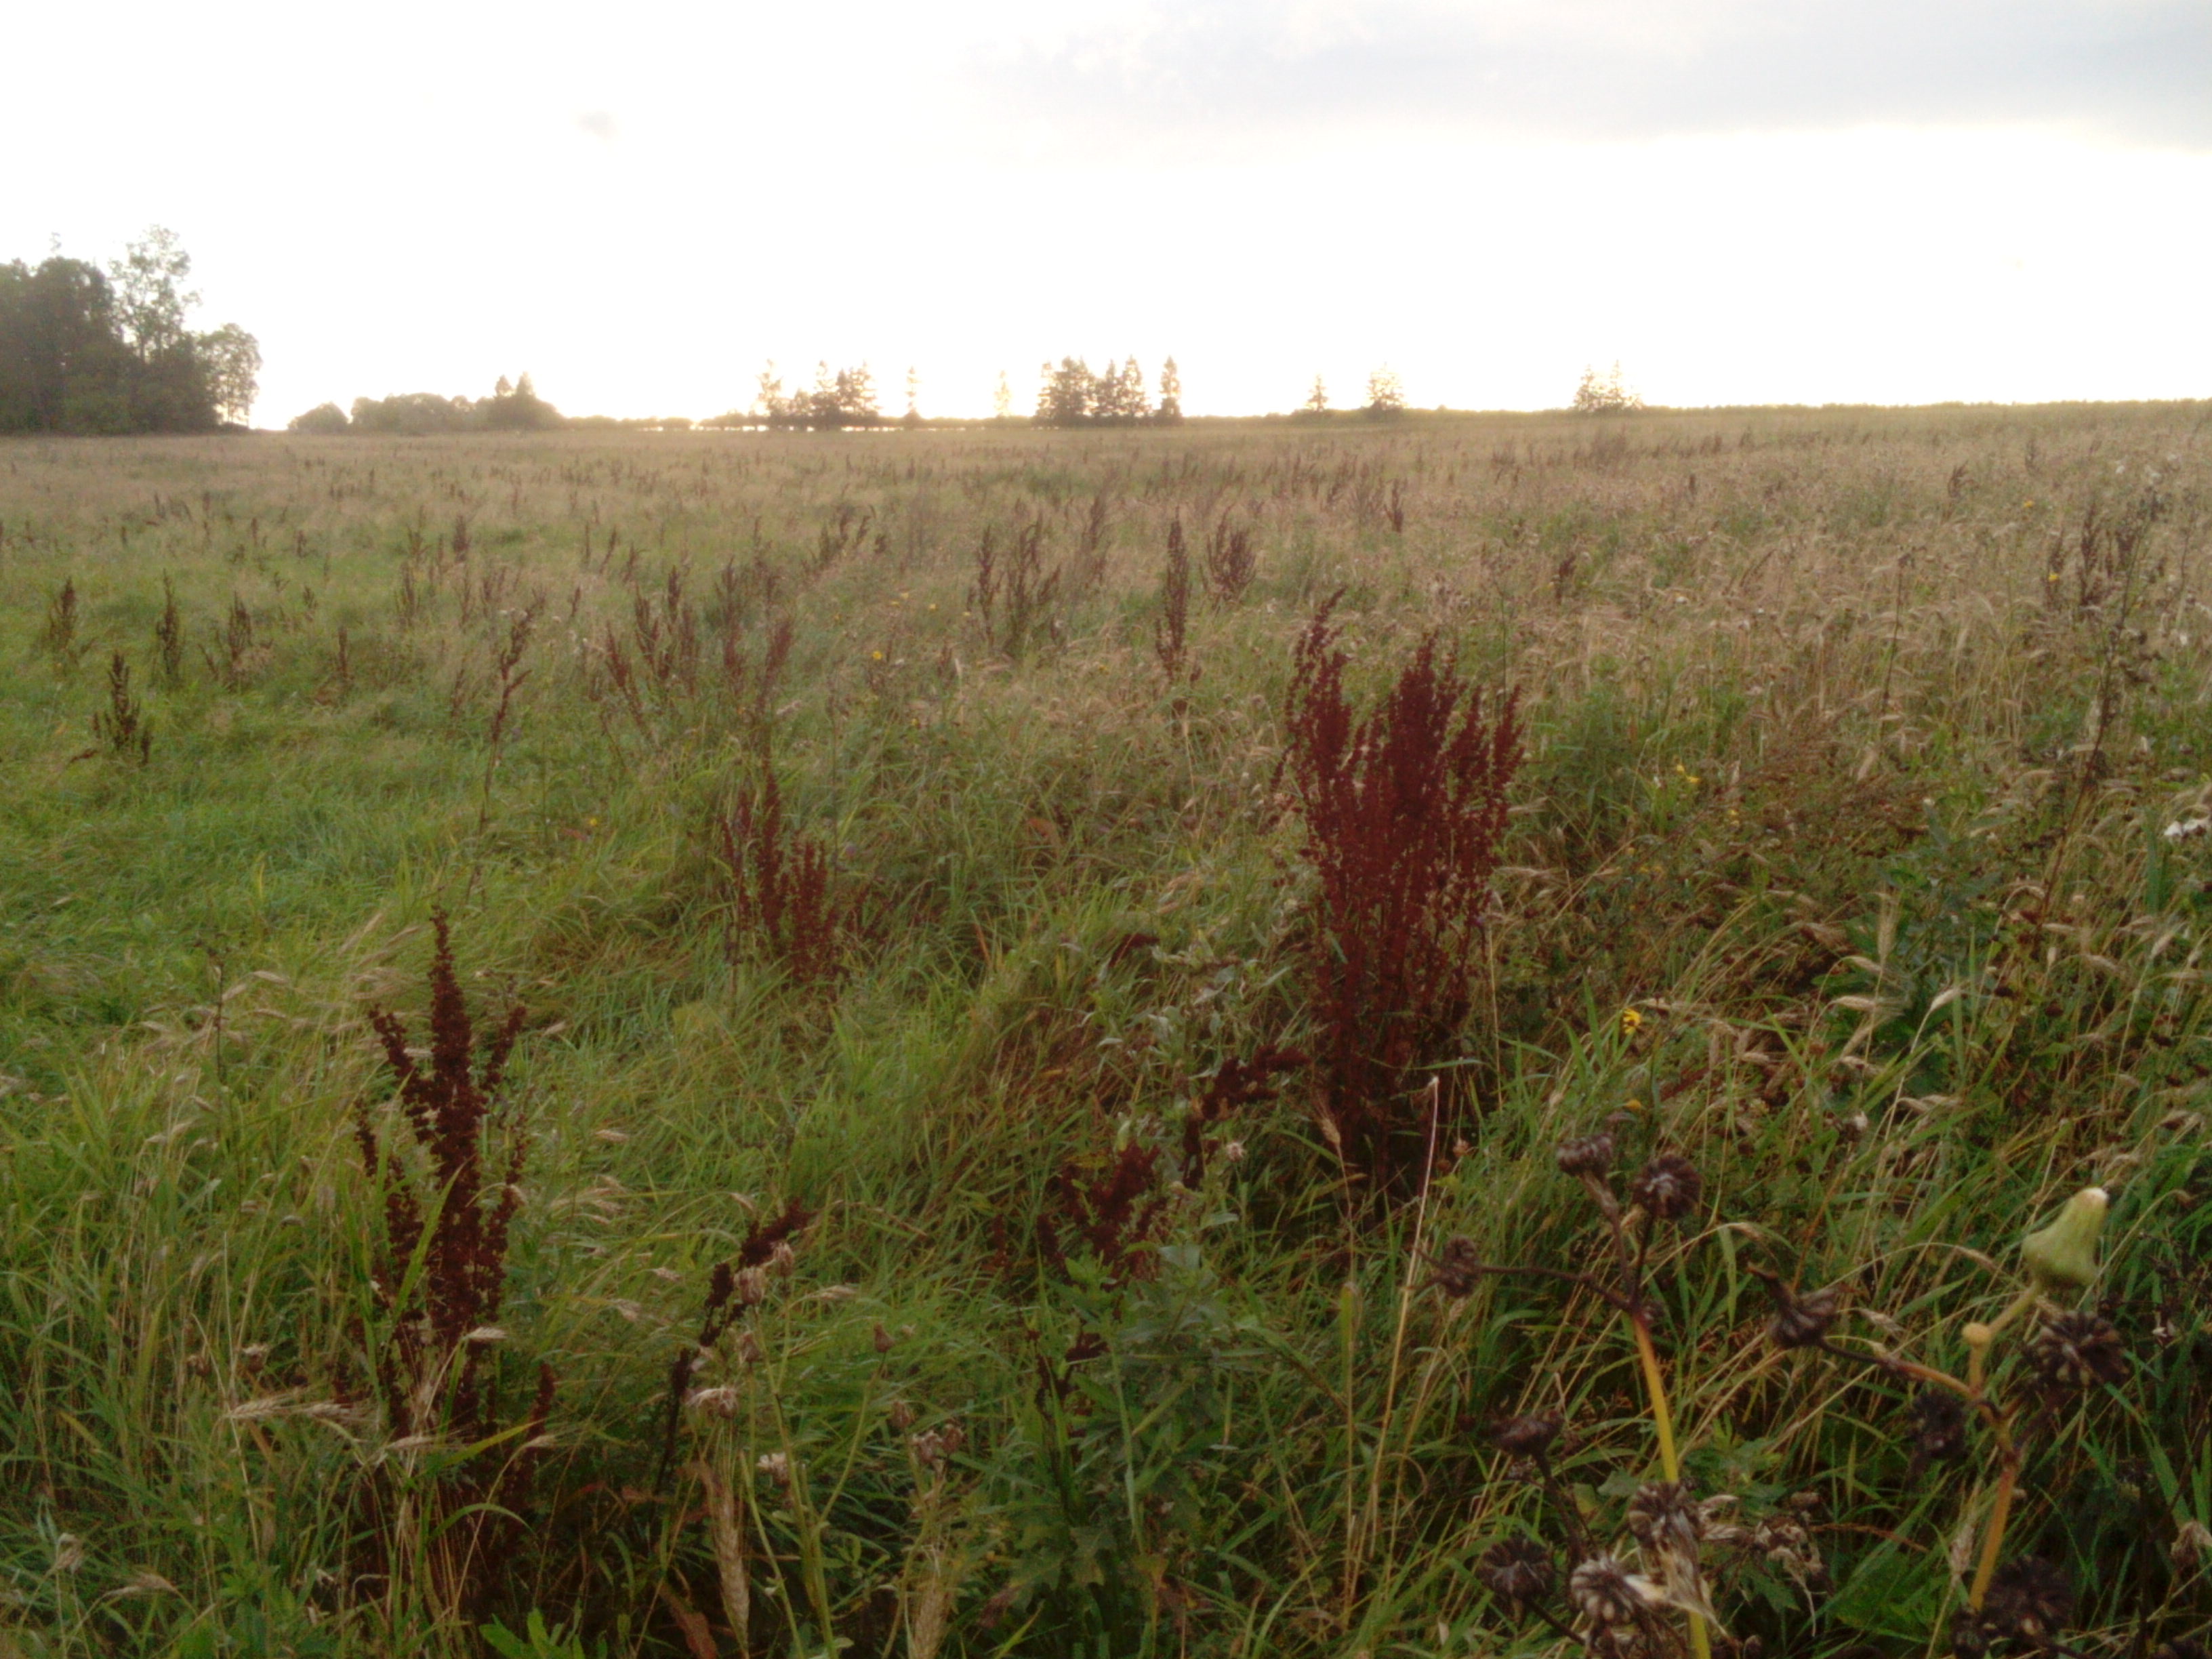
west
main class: Cropland
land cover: Barley
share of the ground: > 75 %
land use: Agriculture (excluding fallow land and kitchen gardens)
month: September
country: LT
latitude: 55.9287
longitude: 22.5931
